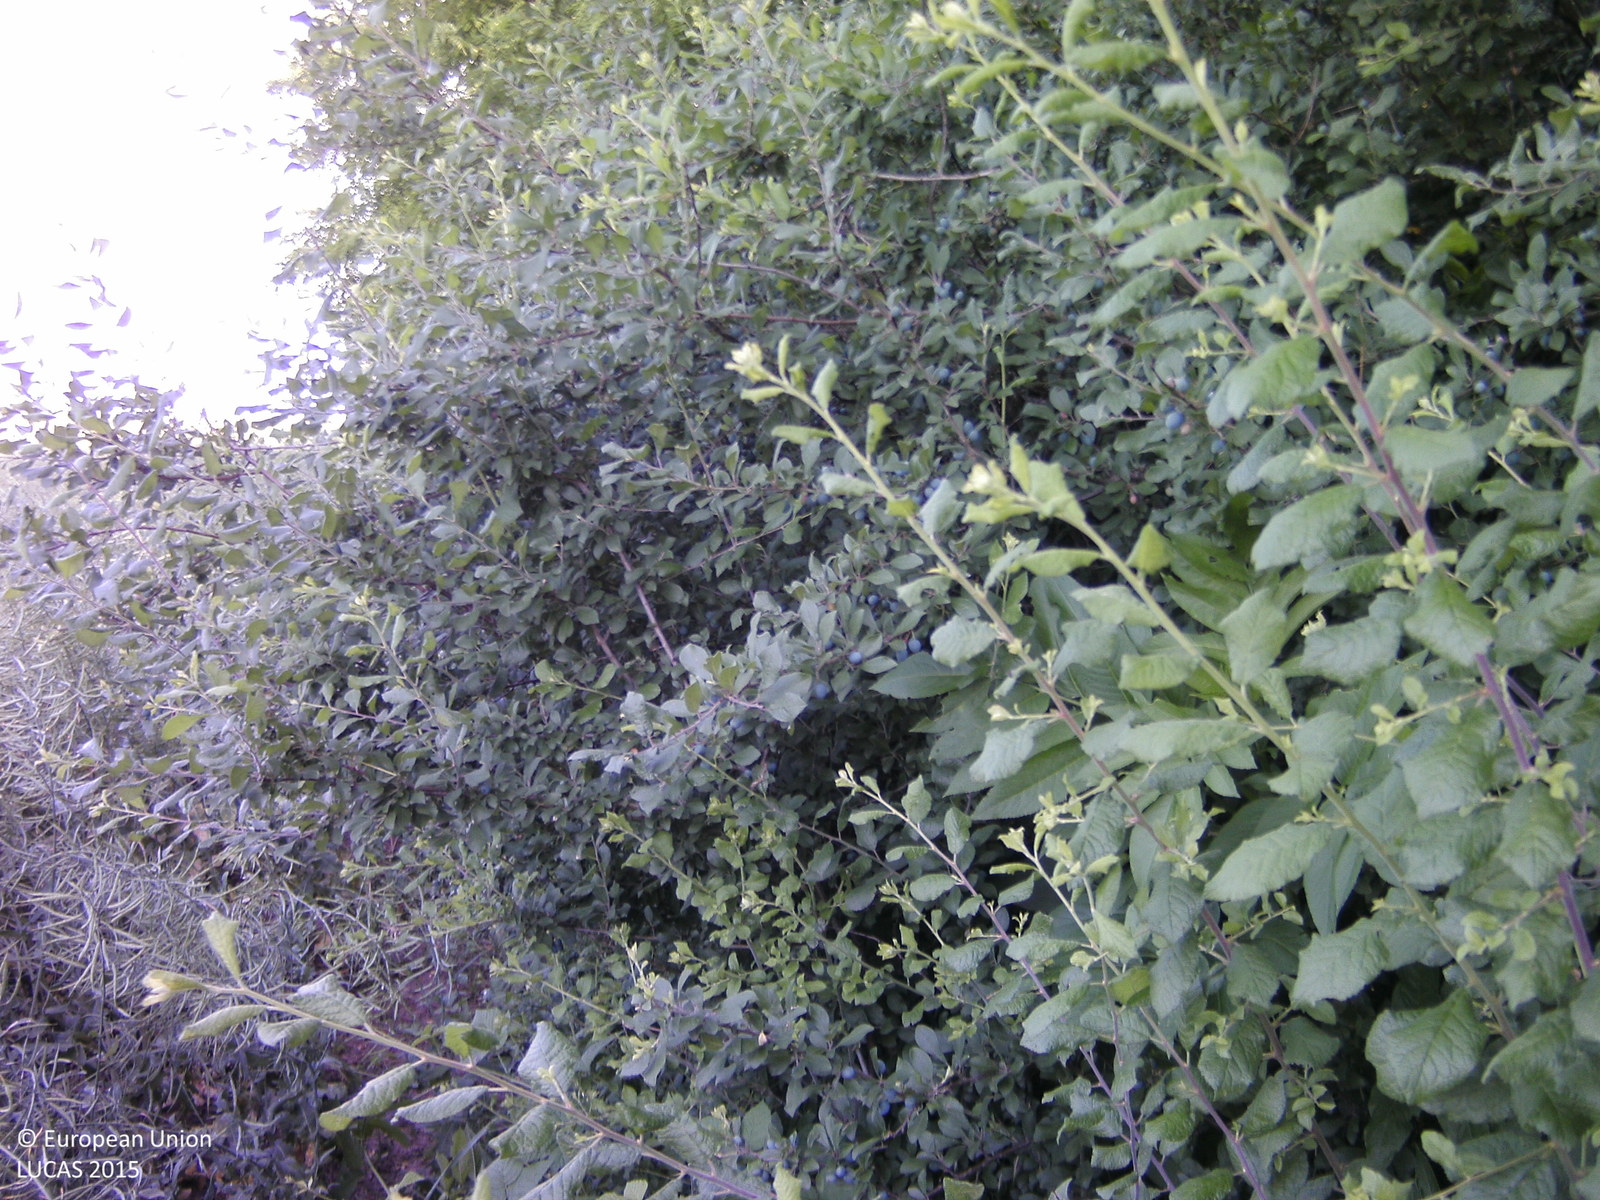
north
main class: Cropland
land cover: Rape and turnip rape
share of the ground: > 75 %
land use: Agriculture (excluding fallow land and kitchen gardens)
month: June
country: HU
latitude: 46.4464
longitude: 18.0392
